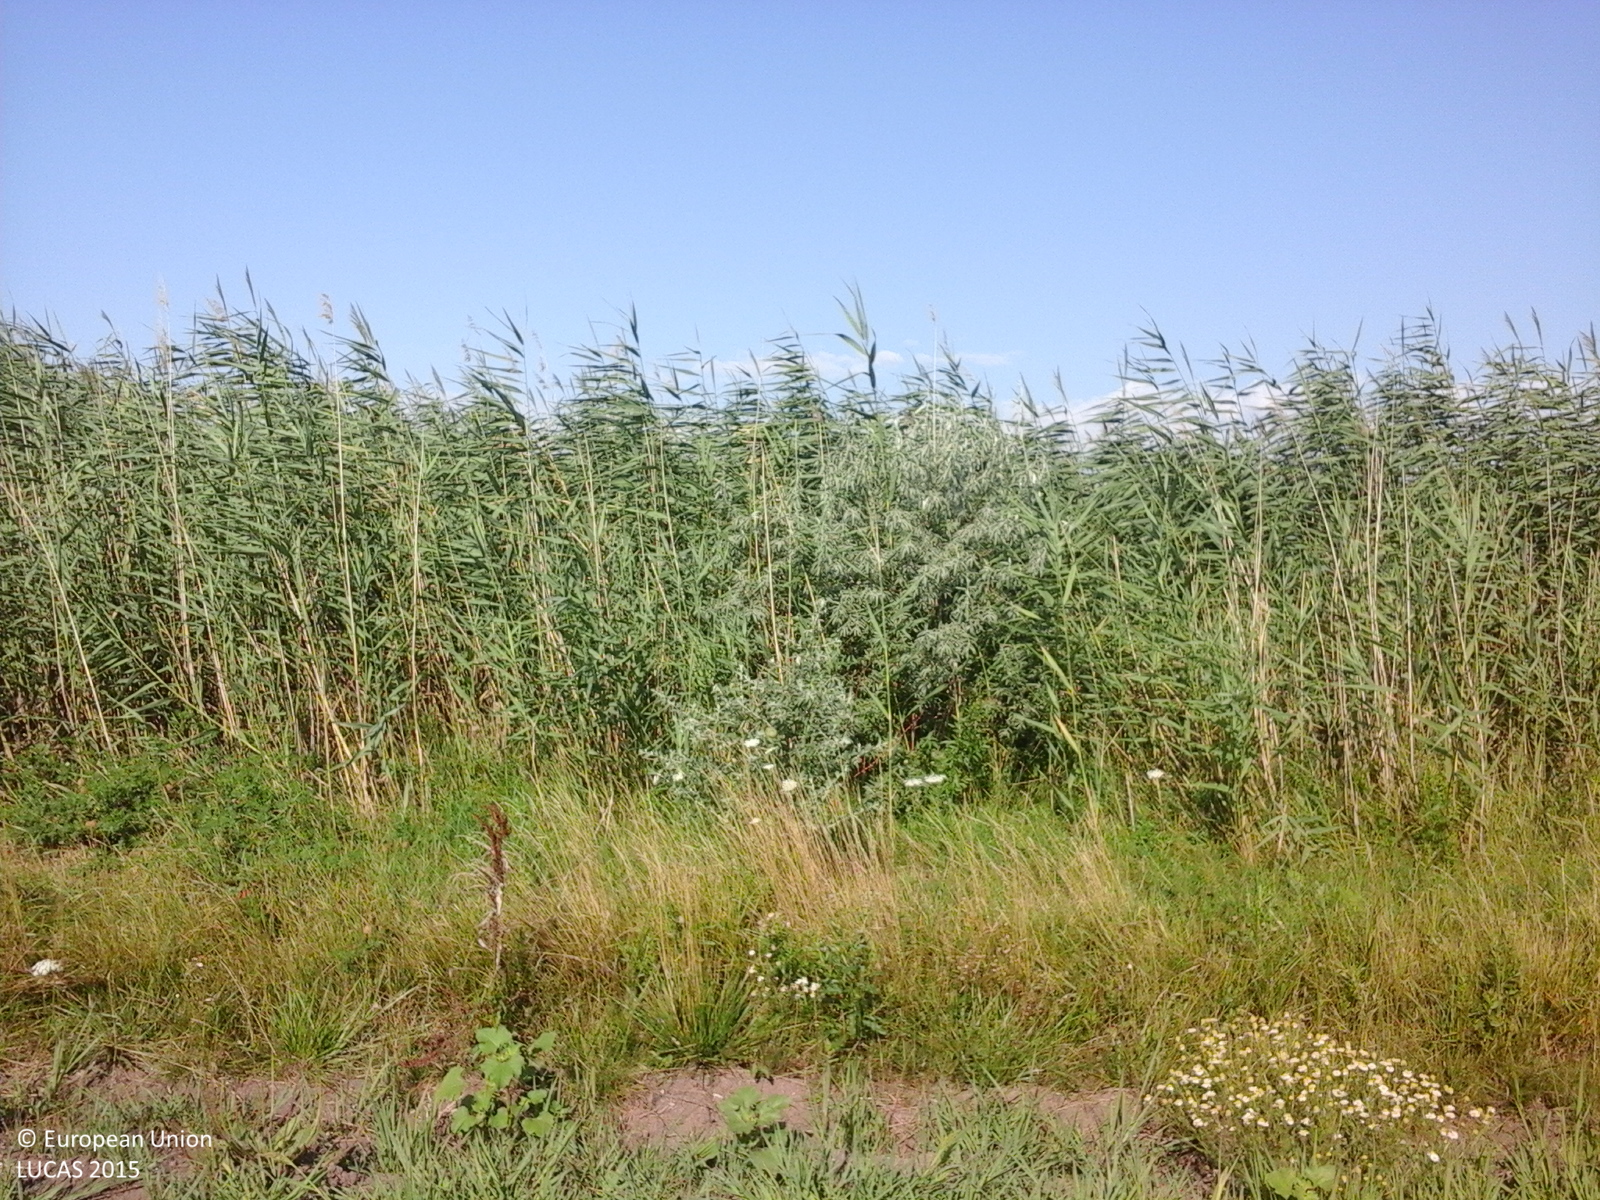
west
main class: Cropland
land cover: Maize
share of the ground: > 75 %
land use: Agriculture (excluding fallow land and kitchen gardens)
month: July
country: RO
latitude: 46.3269
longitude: 28.1725
